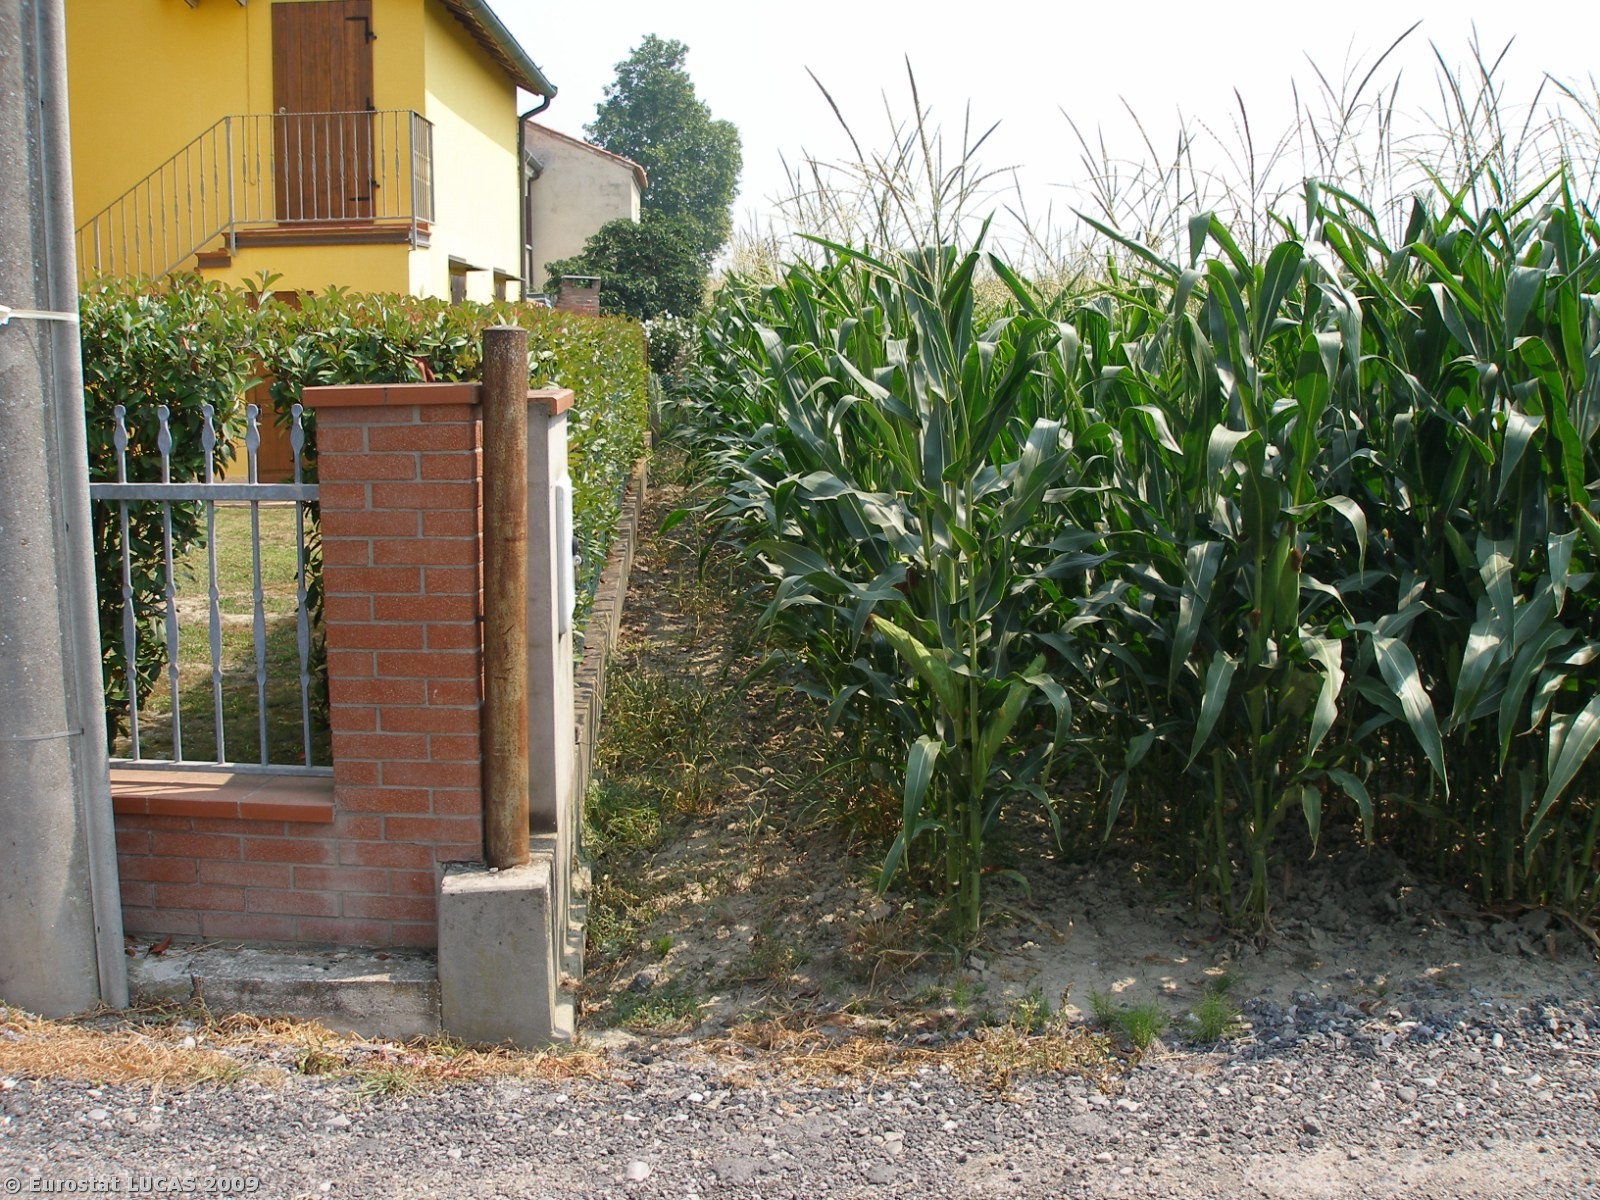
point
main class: Cropland
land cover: Maize
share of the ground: > 75 %
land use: Agriculture (excluding fallow land and kitchen gardens)
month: July
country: IT
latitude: 44.9145
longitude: 11.6562
